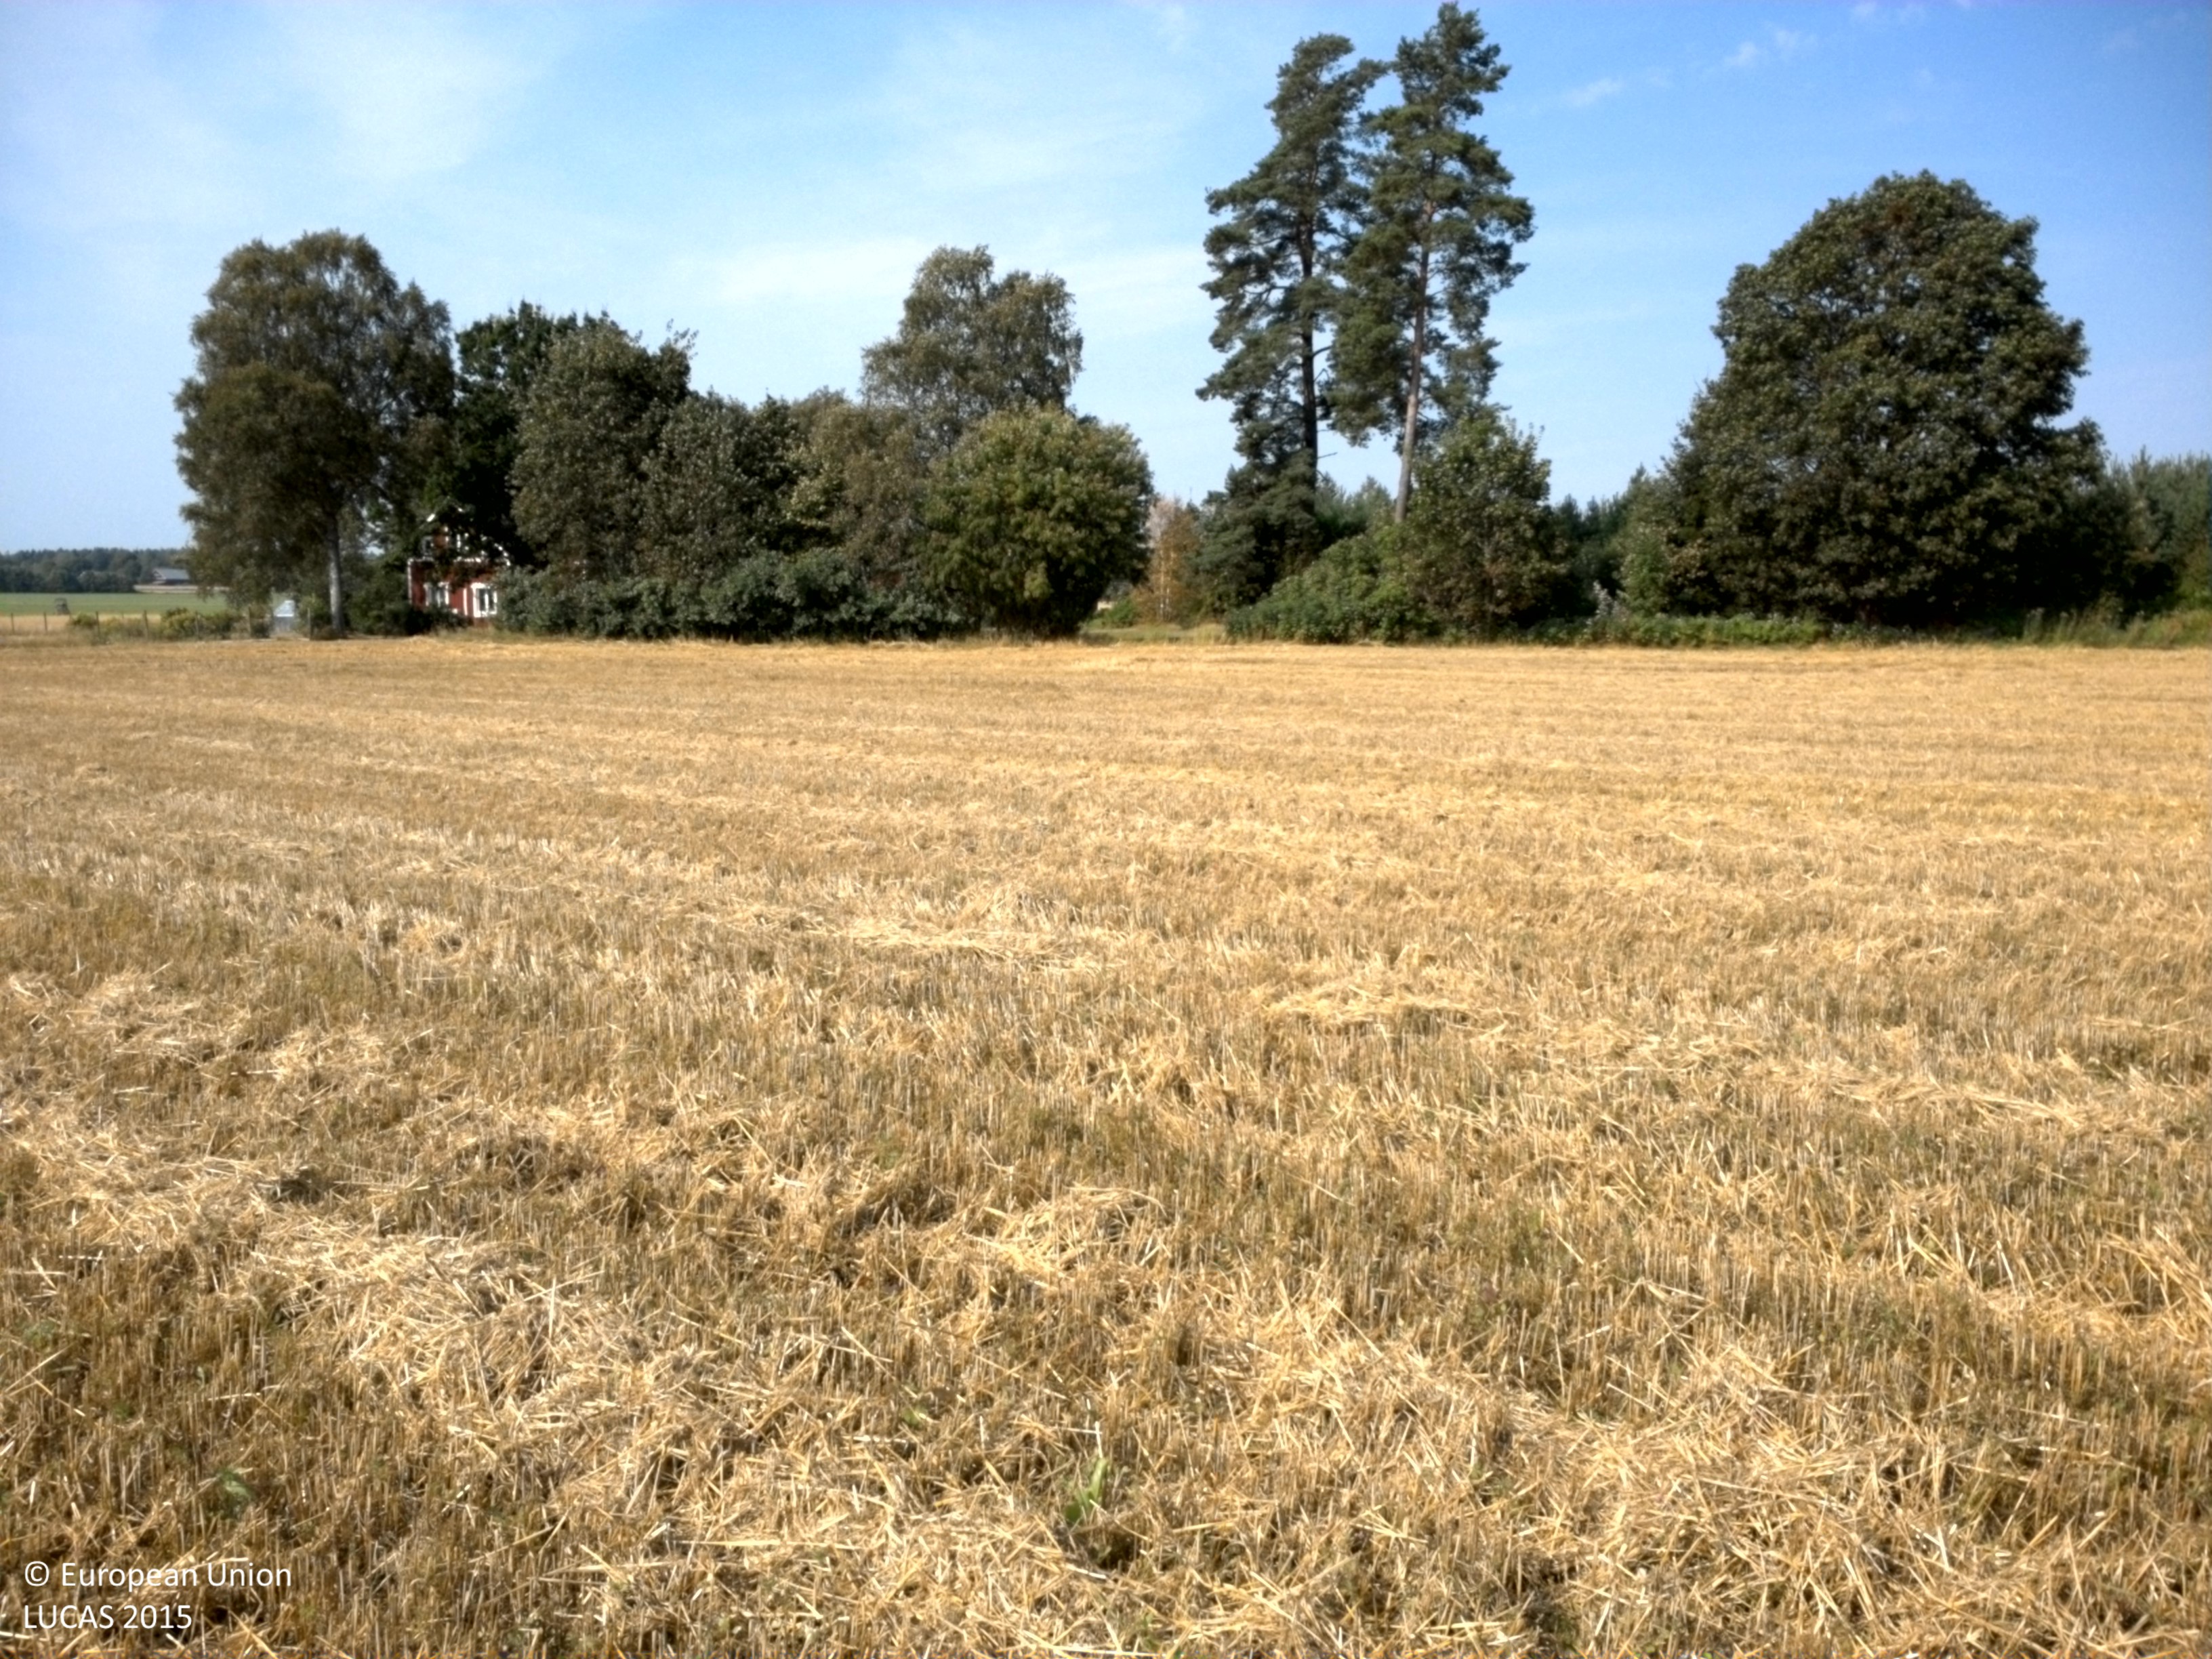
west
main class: Cropland
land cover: Barley
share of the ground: > 75 %
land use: Agriculture (excluding fallow land and kitchen gardens)
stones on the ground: < 10 %
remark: Harvested field
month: August
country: SE
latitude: 60.1061
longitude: 17.5297
